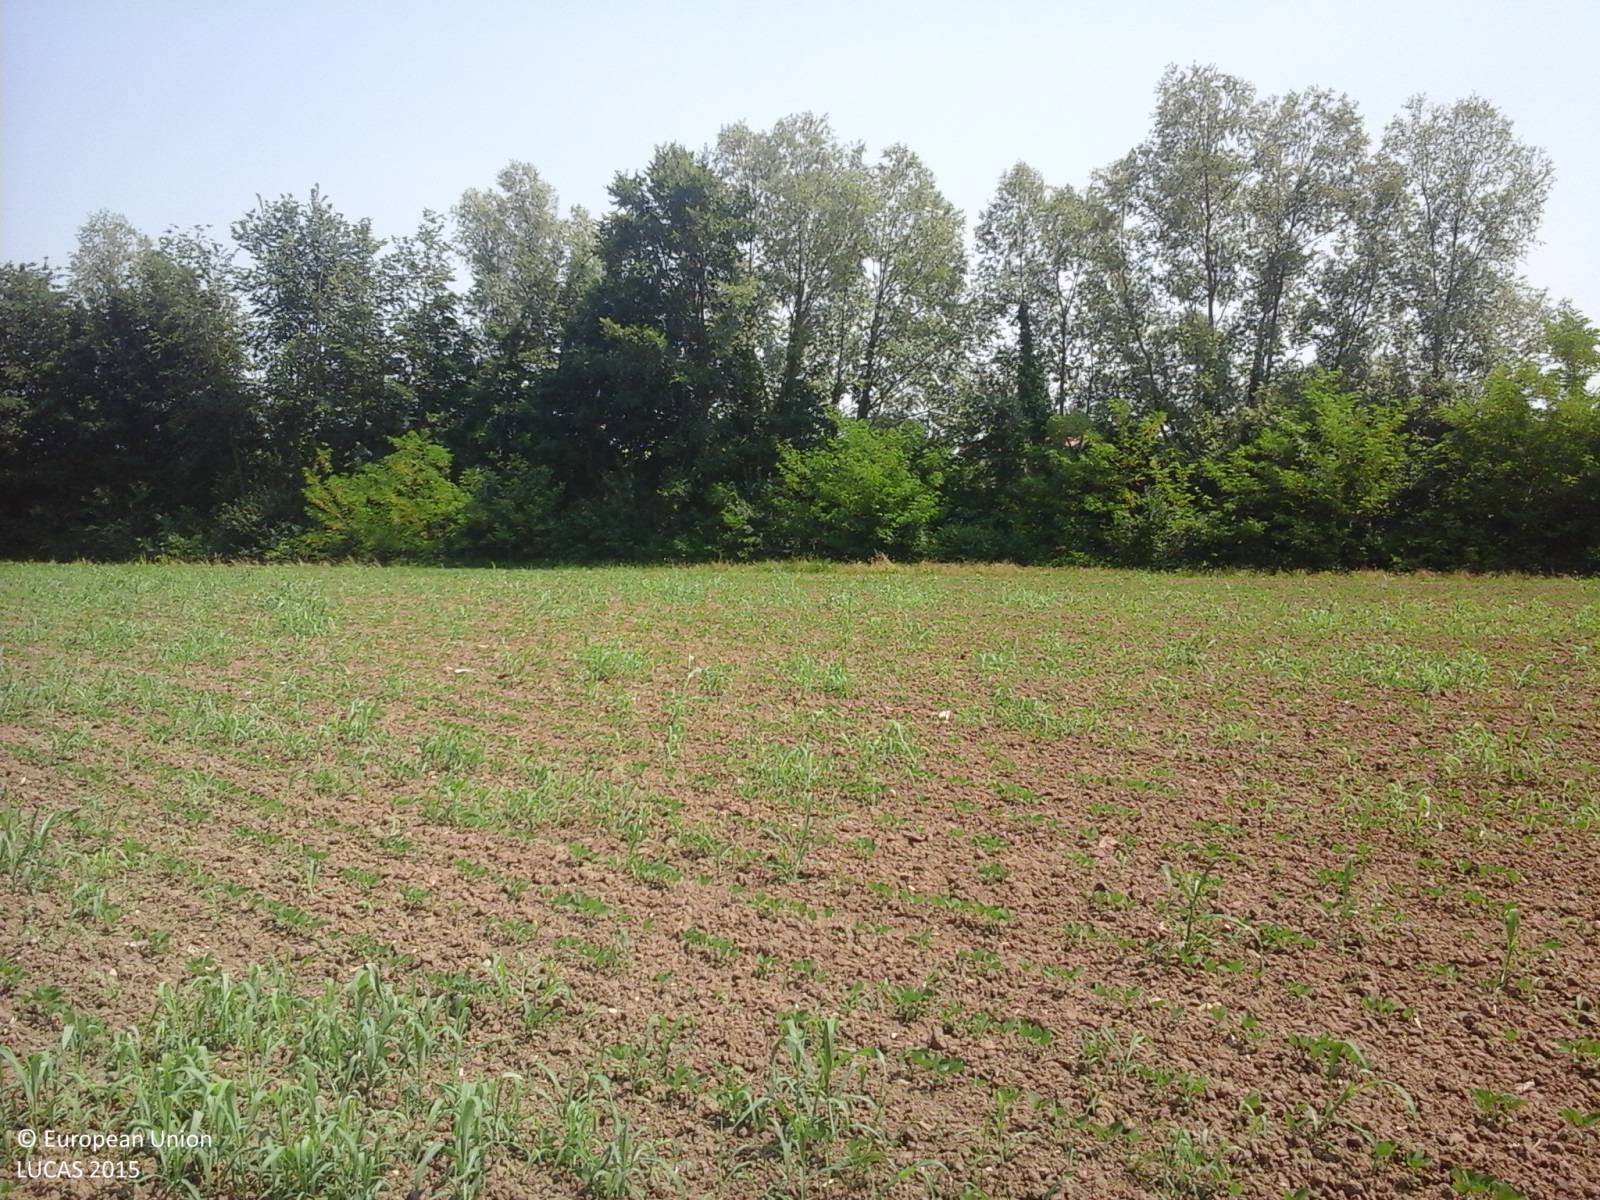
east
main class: Cropland
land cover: Soya
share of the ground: < 10 %
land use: Agriculture (excluding fallow land and kitchen gardens)
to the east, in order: Soya; Grass margins; Lines of trees; Ditches and canals; Lines of trees; Paved roads, cycling and walking lanes; Broadleaved woodland; Grassland without tree/shrub cover; Paved roads, cycling and walking lanes; Lines of trees; Electric lines; Ditches and canals; Grass margins; Paved roads, cycling and walking lanes; Grass margins; Ditches and canals; Lines of trees; Grassland without tree/shrub cover; Inland fresh running water; Grassland without tree/shrub cover; Broadleaved woodland
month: June
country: IT
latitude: 45.8712
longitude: 12.5087
